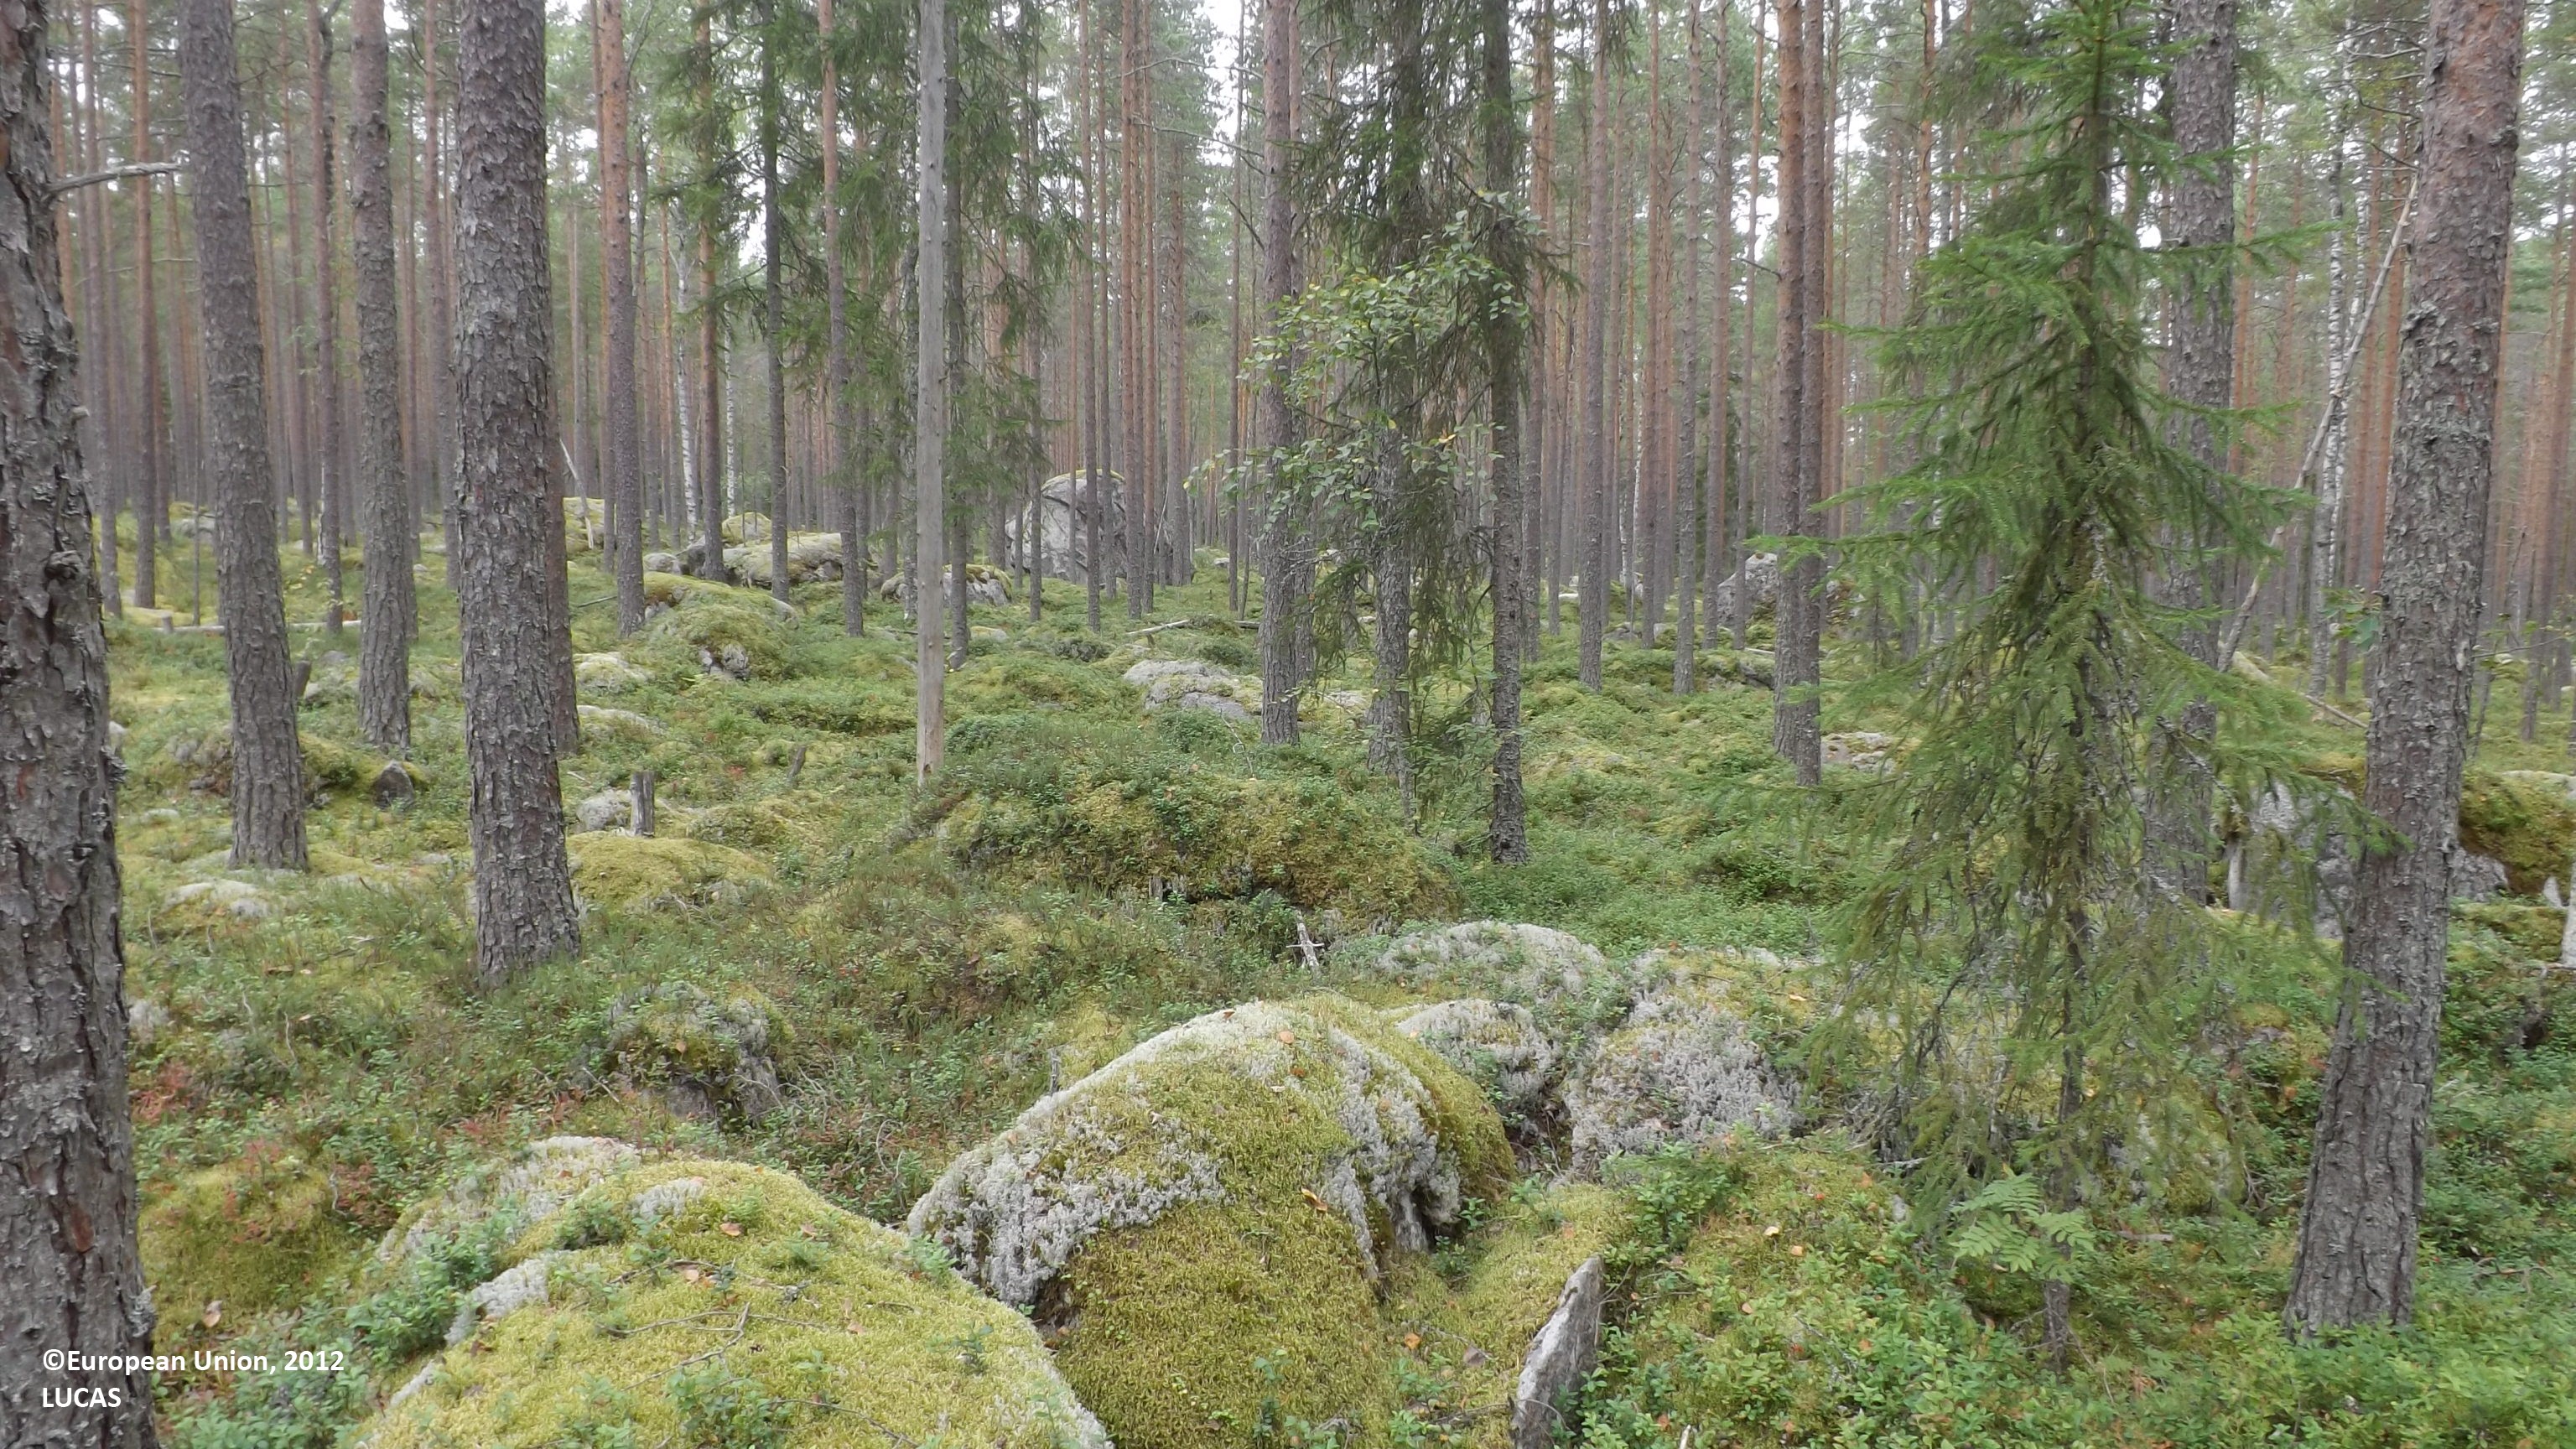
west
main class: Woodland
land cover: Pine dominated coniferous woodland
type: boreal forest
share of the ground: 50 - 75 %
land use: Forestry
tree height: > 5 m
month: August
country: FI
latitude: 63.9672
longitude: 24.0973
